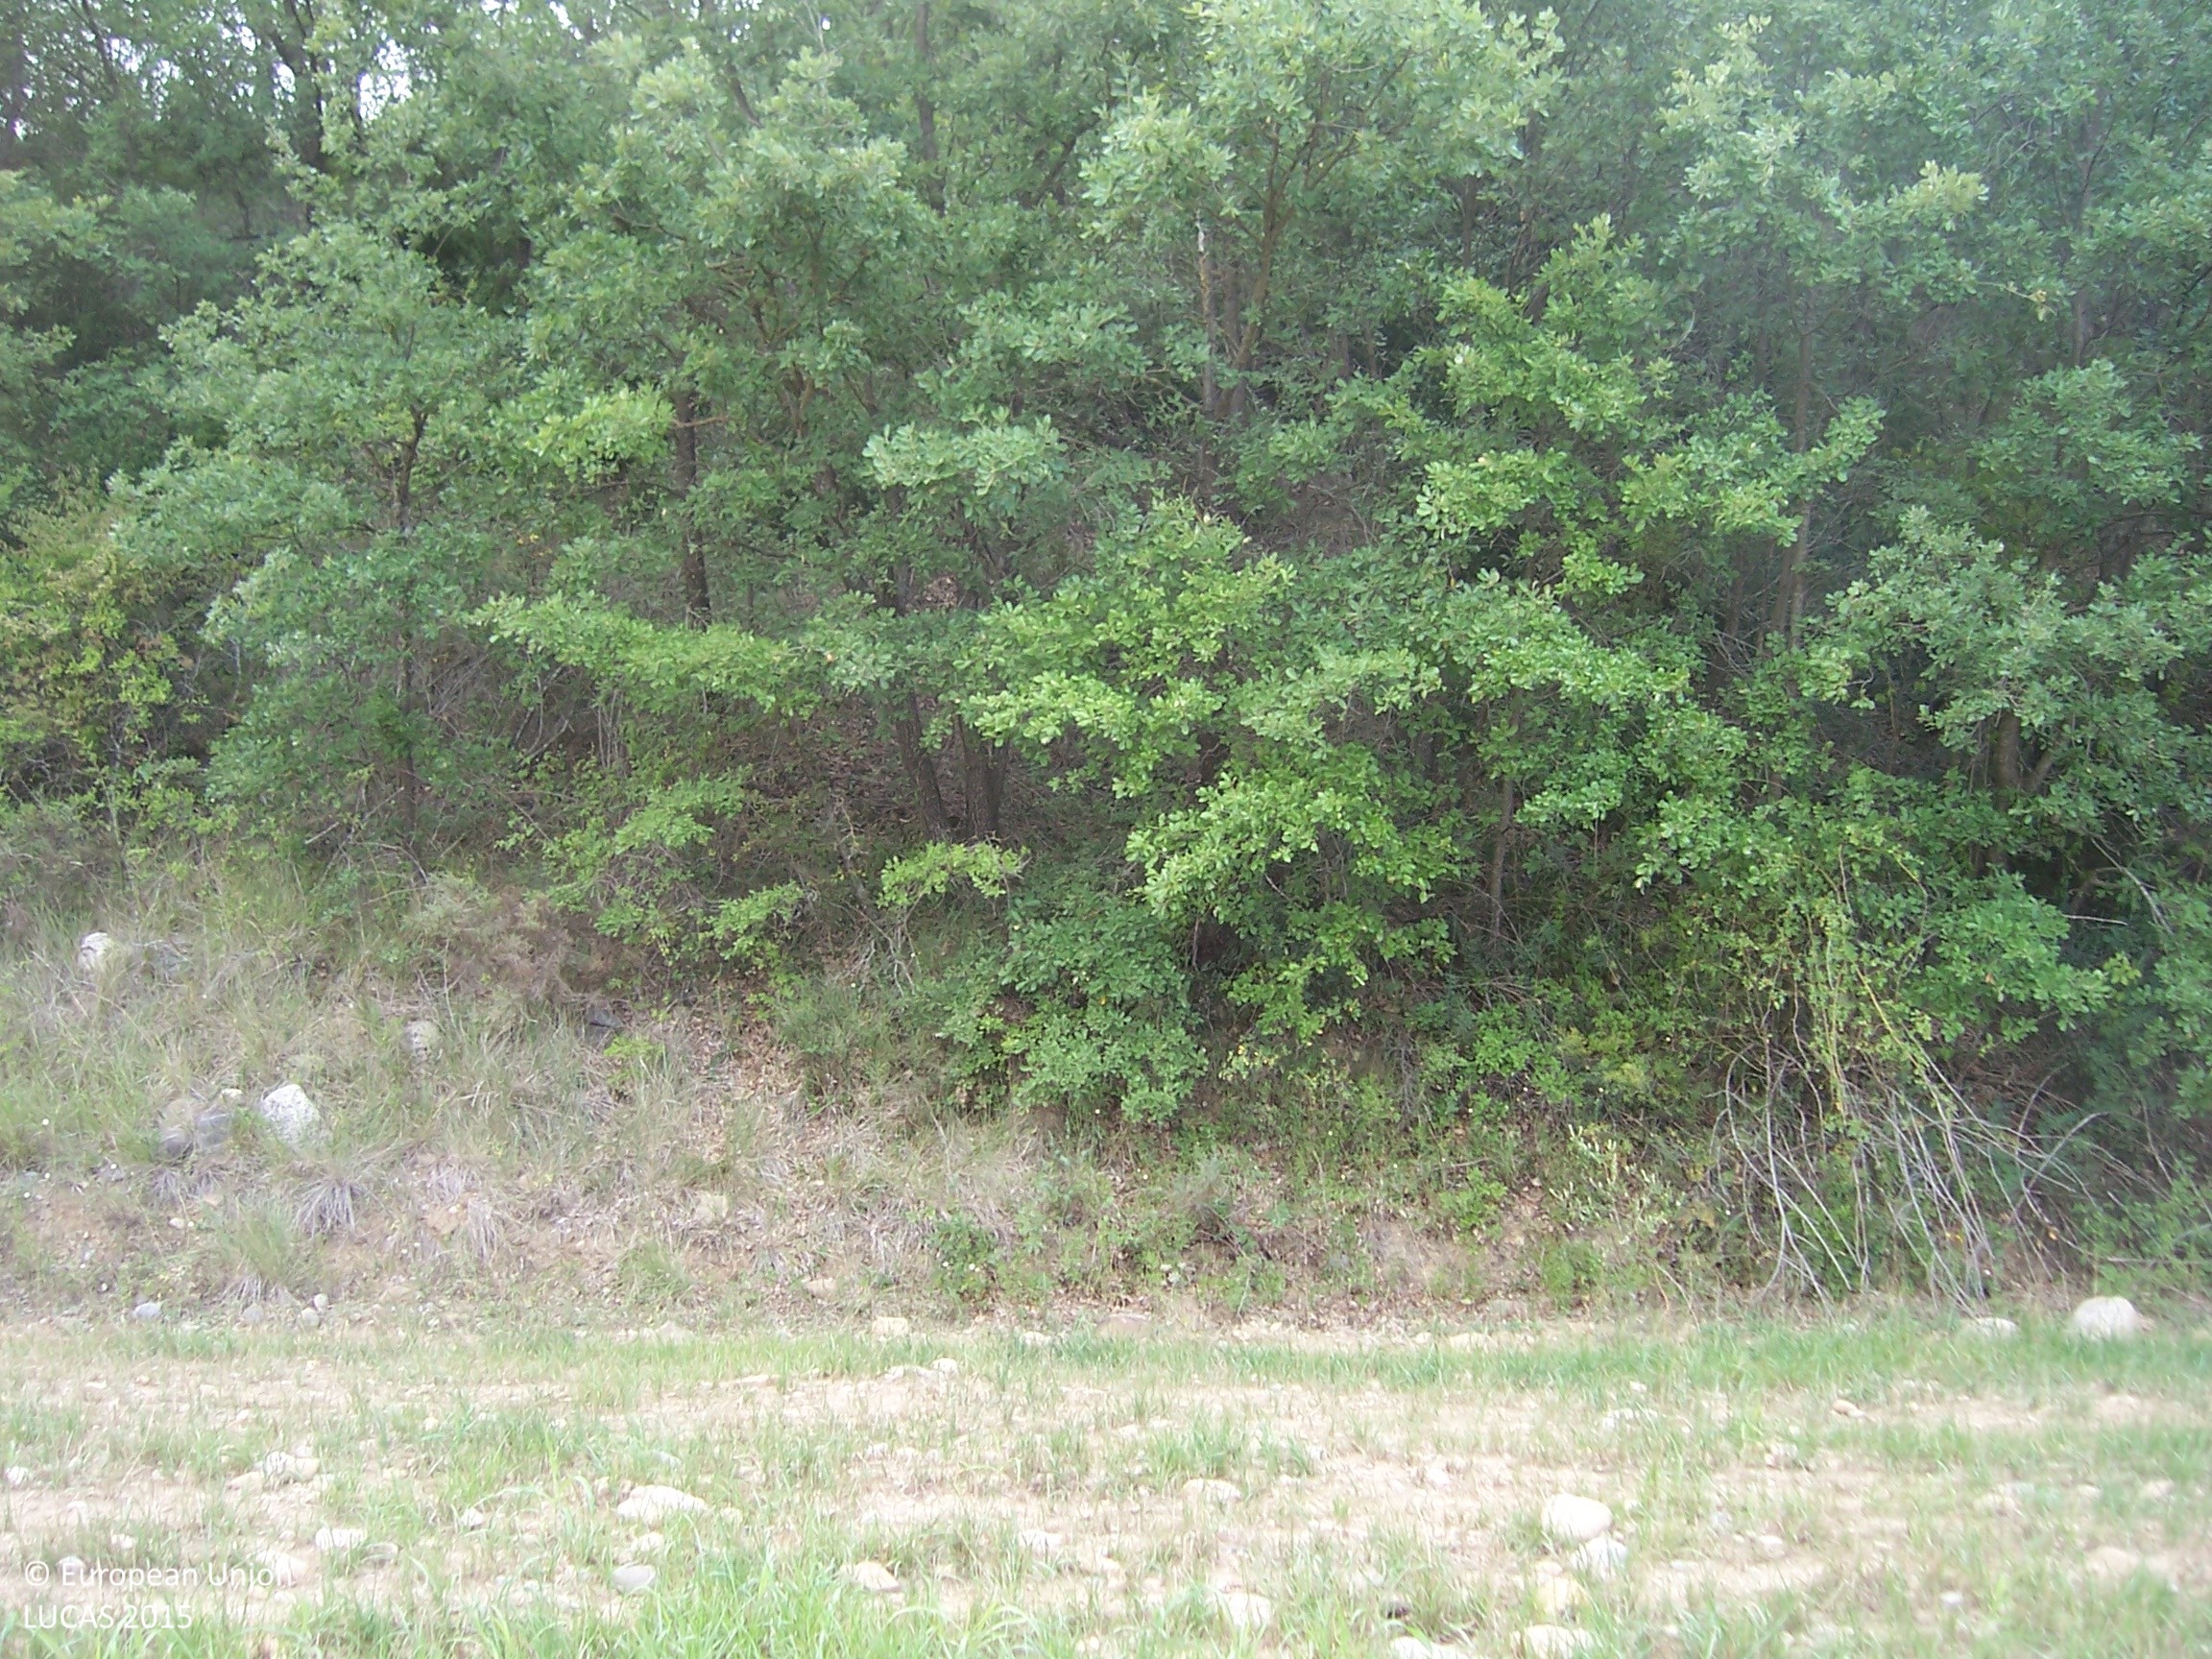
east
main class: Grassland
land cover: Spontaneously vegetated surfaces
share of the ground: > 75 %
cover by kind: herbaceous plants 60 %, unconsolidated bare surface 40 %
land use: Fallow land
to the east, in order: Spontaneously vegetated surfaces; Broadleaved woodland; Spontaneously vegetated surfaces; Electric lines; Spontaneously vegetated surfaces; Broadleaved woodland; Grass margins; Paved roads, cycling and walking lanes; Grass margins; Other bare soil
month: August
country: ES
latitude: 42.4269
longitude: 0.1459
